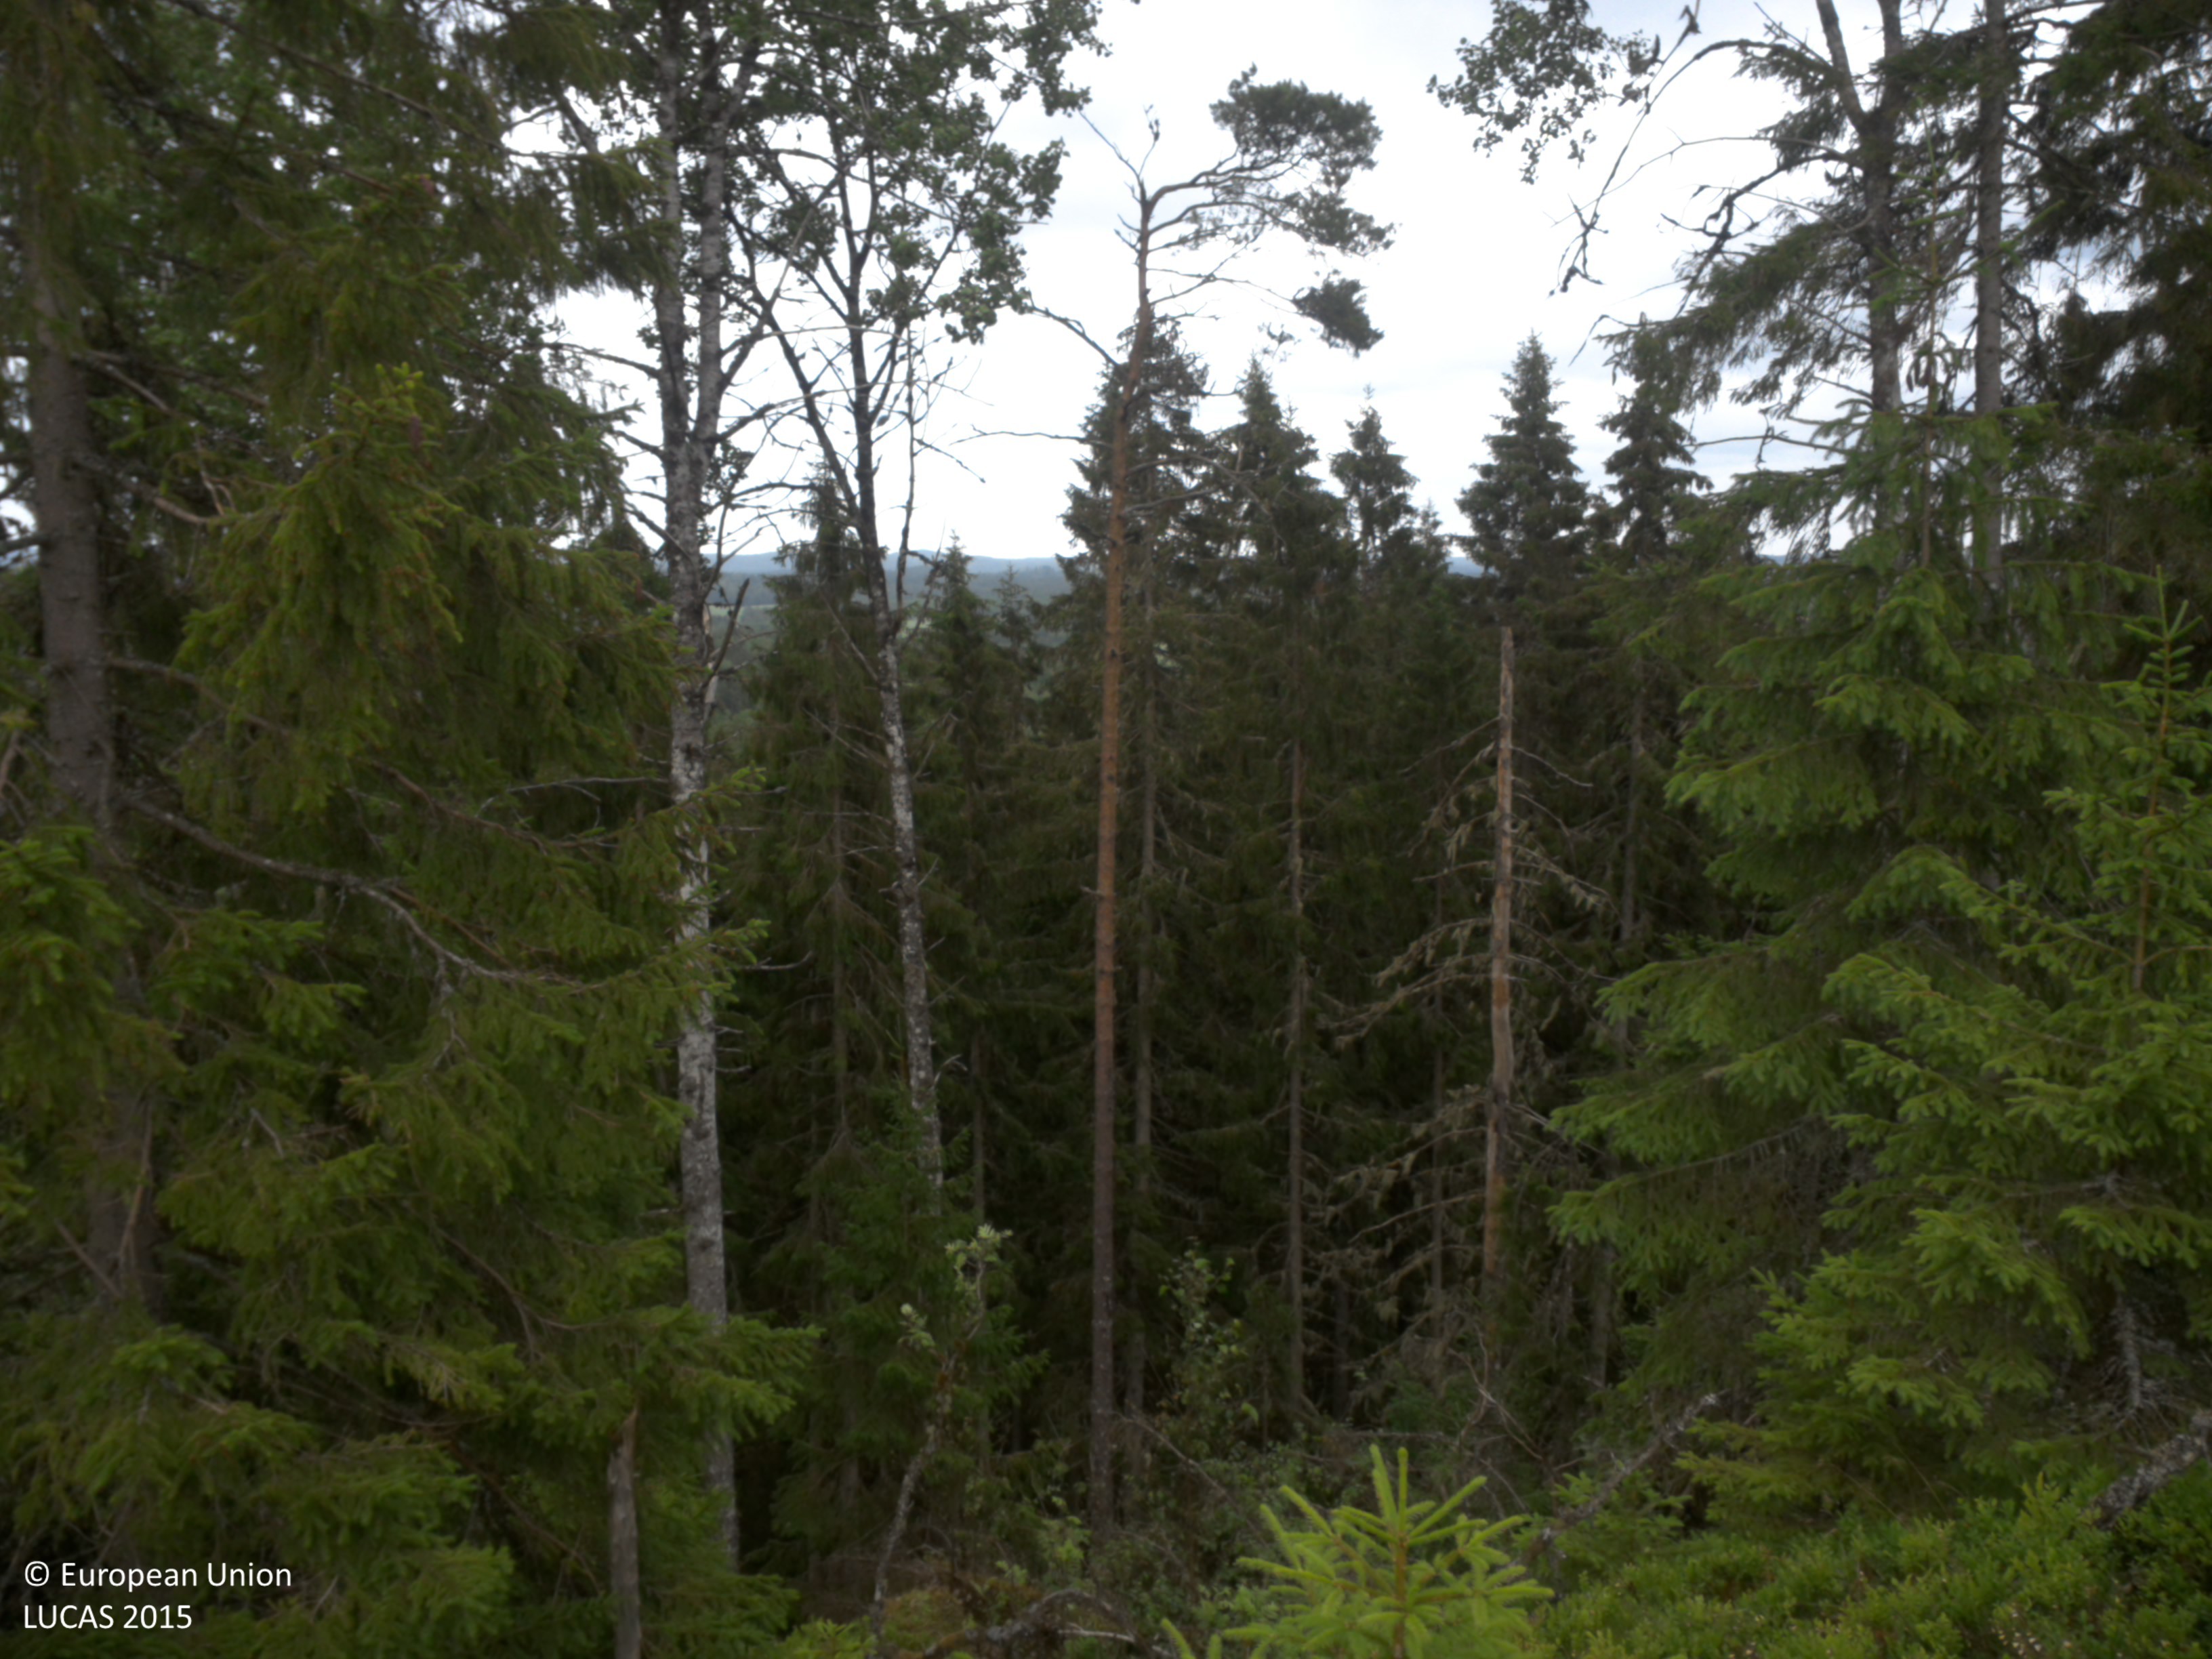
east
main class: Shrubland
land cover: Shrubland with sparse tree cover
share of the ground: 50 - 75 %
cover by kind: shrubs 50 %, herbaceous plants 40 %, coniferous forest trees 5 %, lichens and mosses 5 %
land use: Forestry
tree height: < 5 m
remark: Clear cut
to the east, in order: Shrubland with sparse tree cover; Spruce dominated coniferous woodland; Rock outcrops; Spruce dominated coniferous woodland
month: July
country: SE
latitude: 58.8710
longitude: 11.9552
